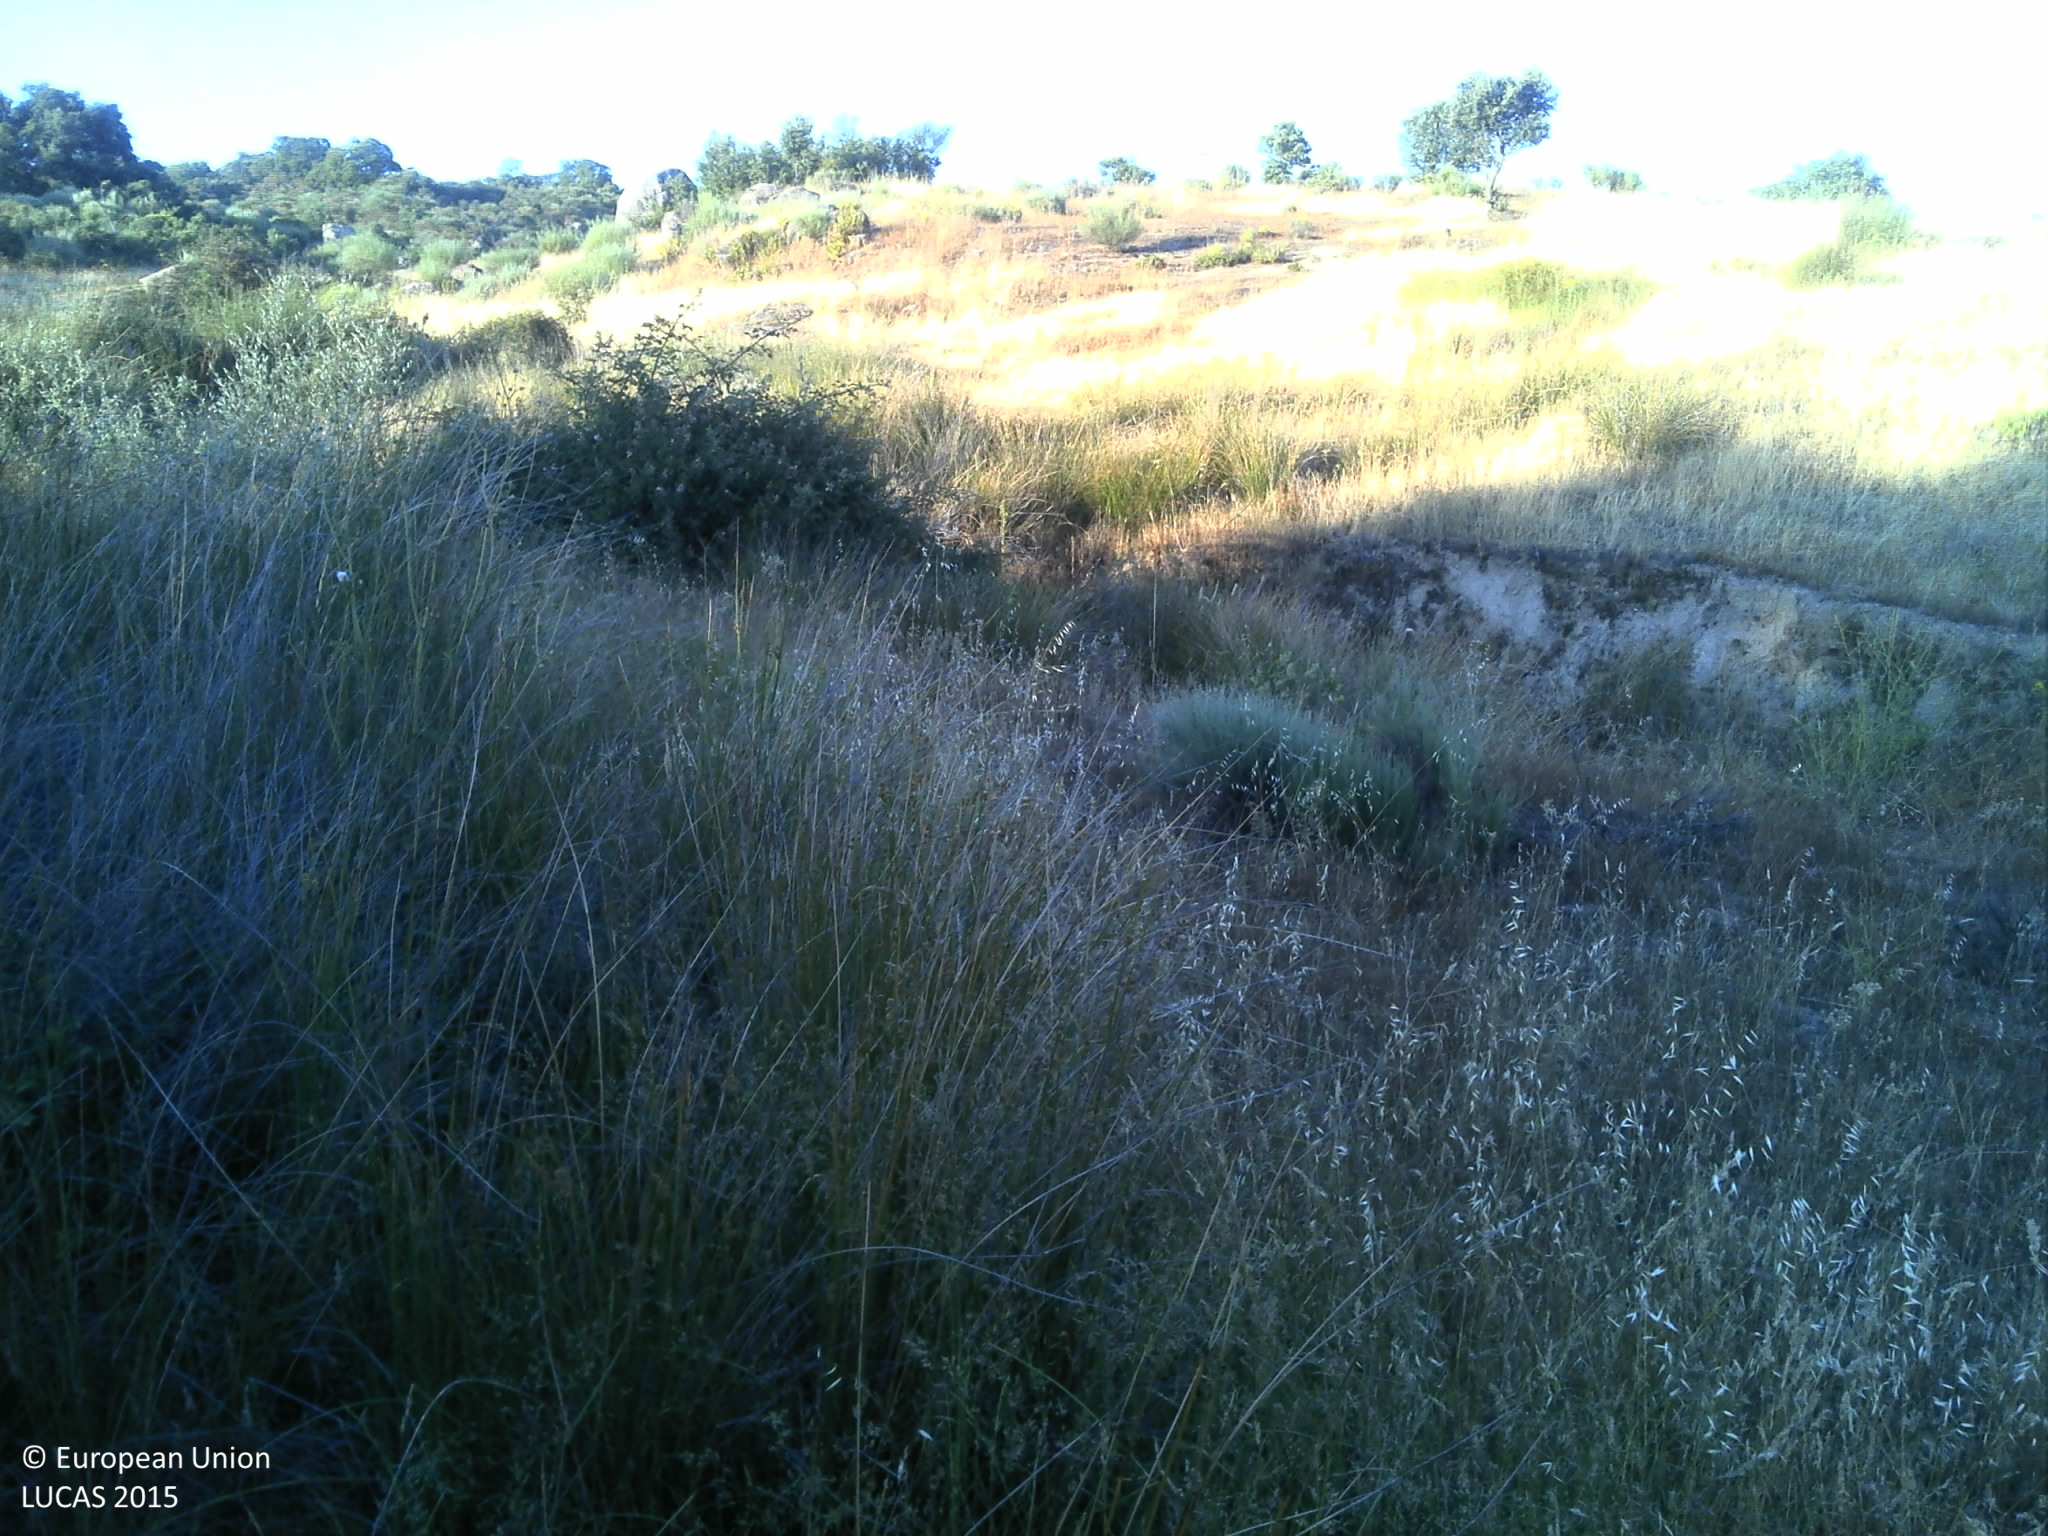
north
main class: Grassland
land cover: Grassland without tree/shrub cover
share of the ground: 50 - 75 %
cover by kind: herbaceous plants 70 %, unconsolidated bare surface 20 %, shrubs 5 %
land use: Agriculture (excluding fallow land and kitchen gardens)
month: June
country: PT
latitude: 39.9819
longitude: -7.3474
